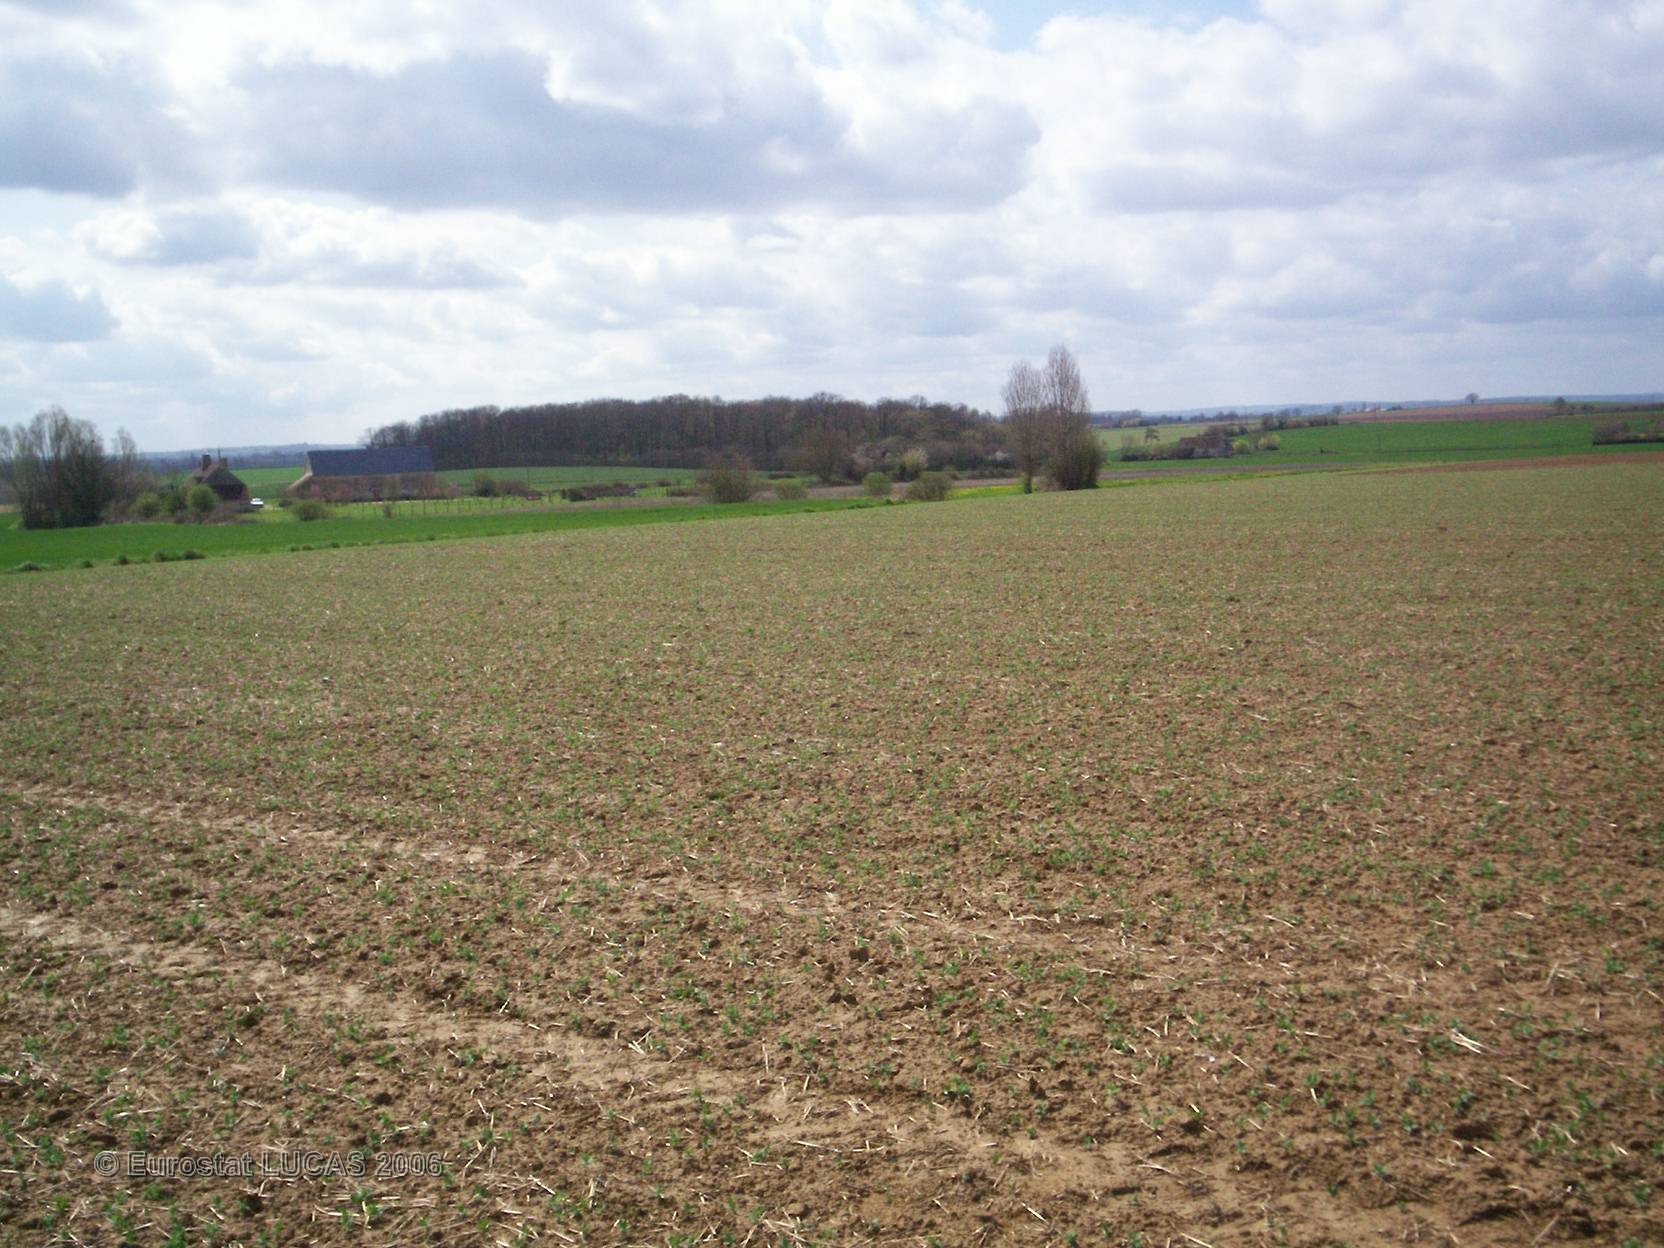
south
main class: Cropland
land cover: Dry pulses
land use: Agriculture (excluding fallow land and kitchen gardens)
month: April
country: FR
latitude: 48.2780
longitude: 0.2309
